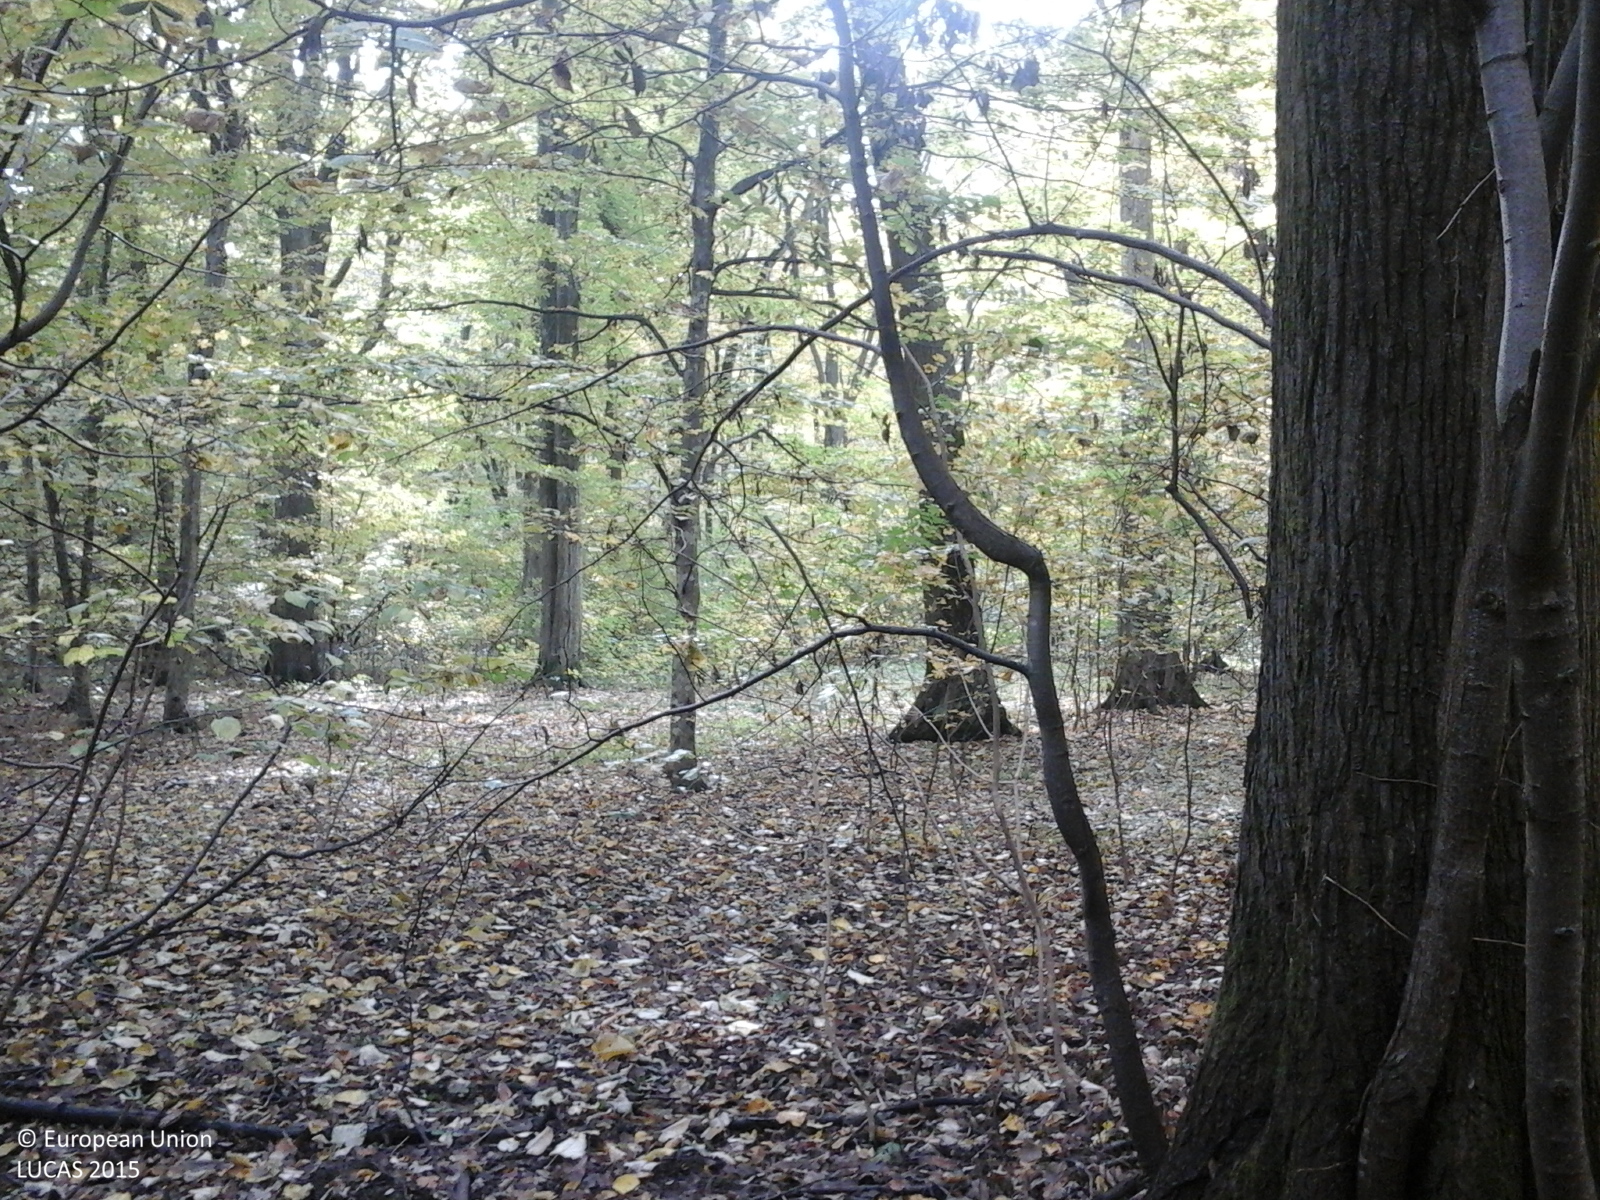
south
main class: Woodland
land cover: Broadleaved woodland
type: beech forest
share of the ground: > 75 %
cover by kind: broadleaved forest trees 100 %
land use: Forestry
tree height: > 5 m
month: October
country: RO
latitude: 44.7094
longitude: 26.1520
